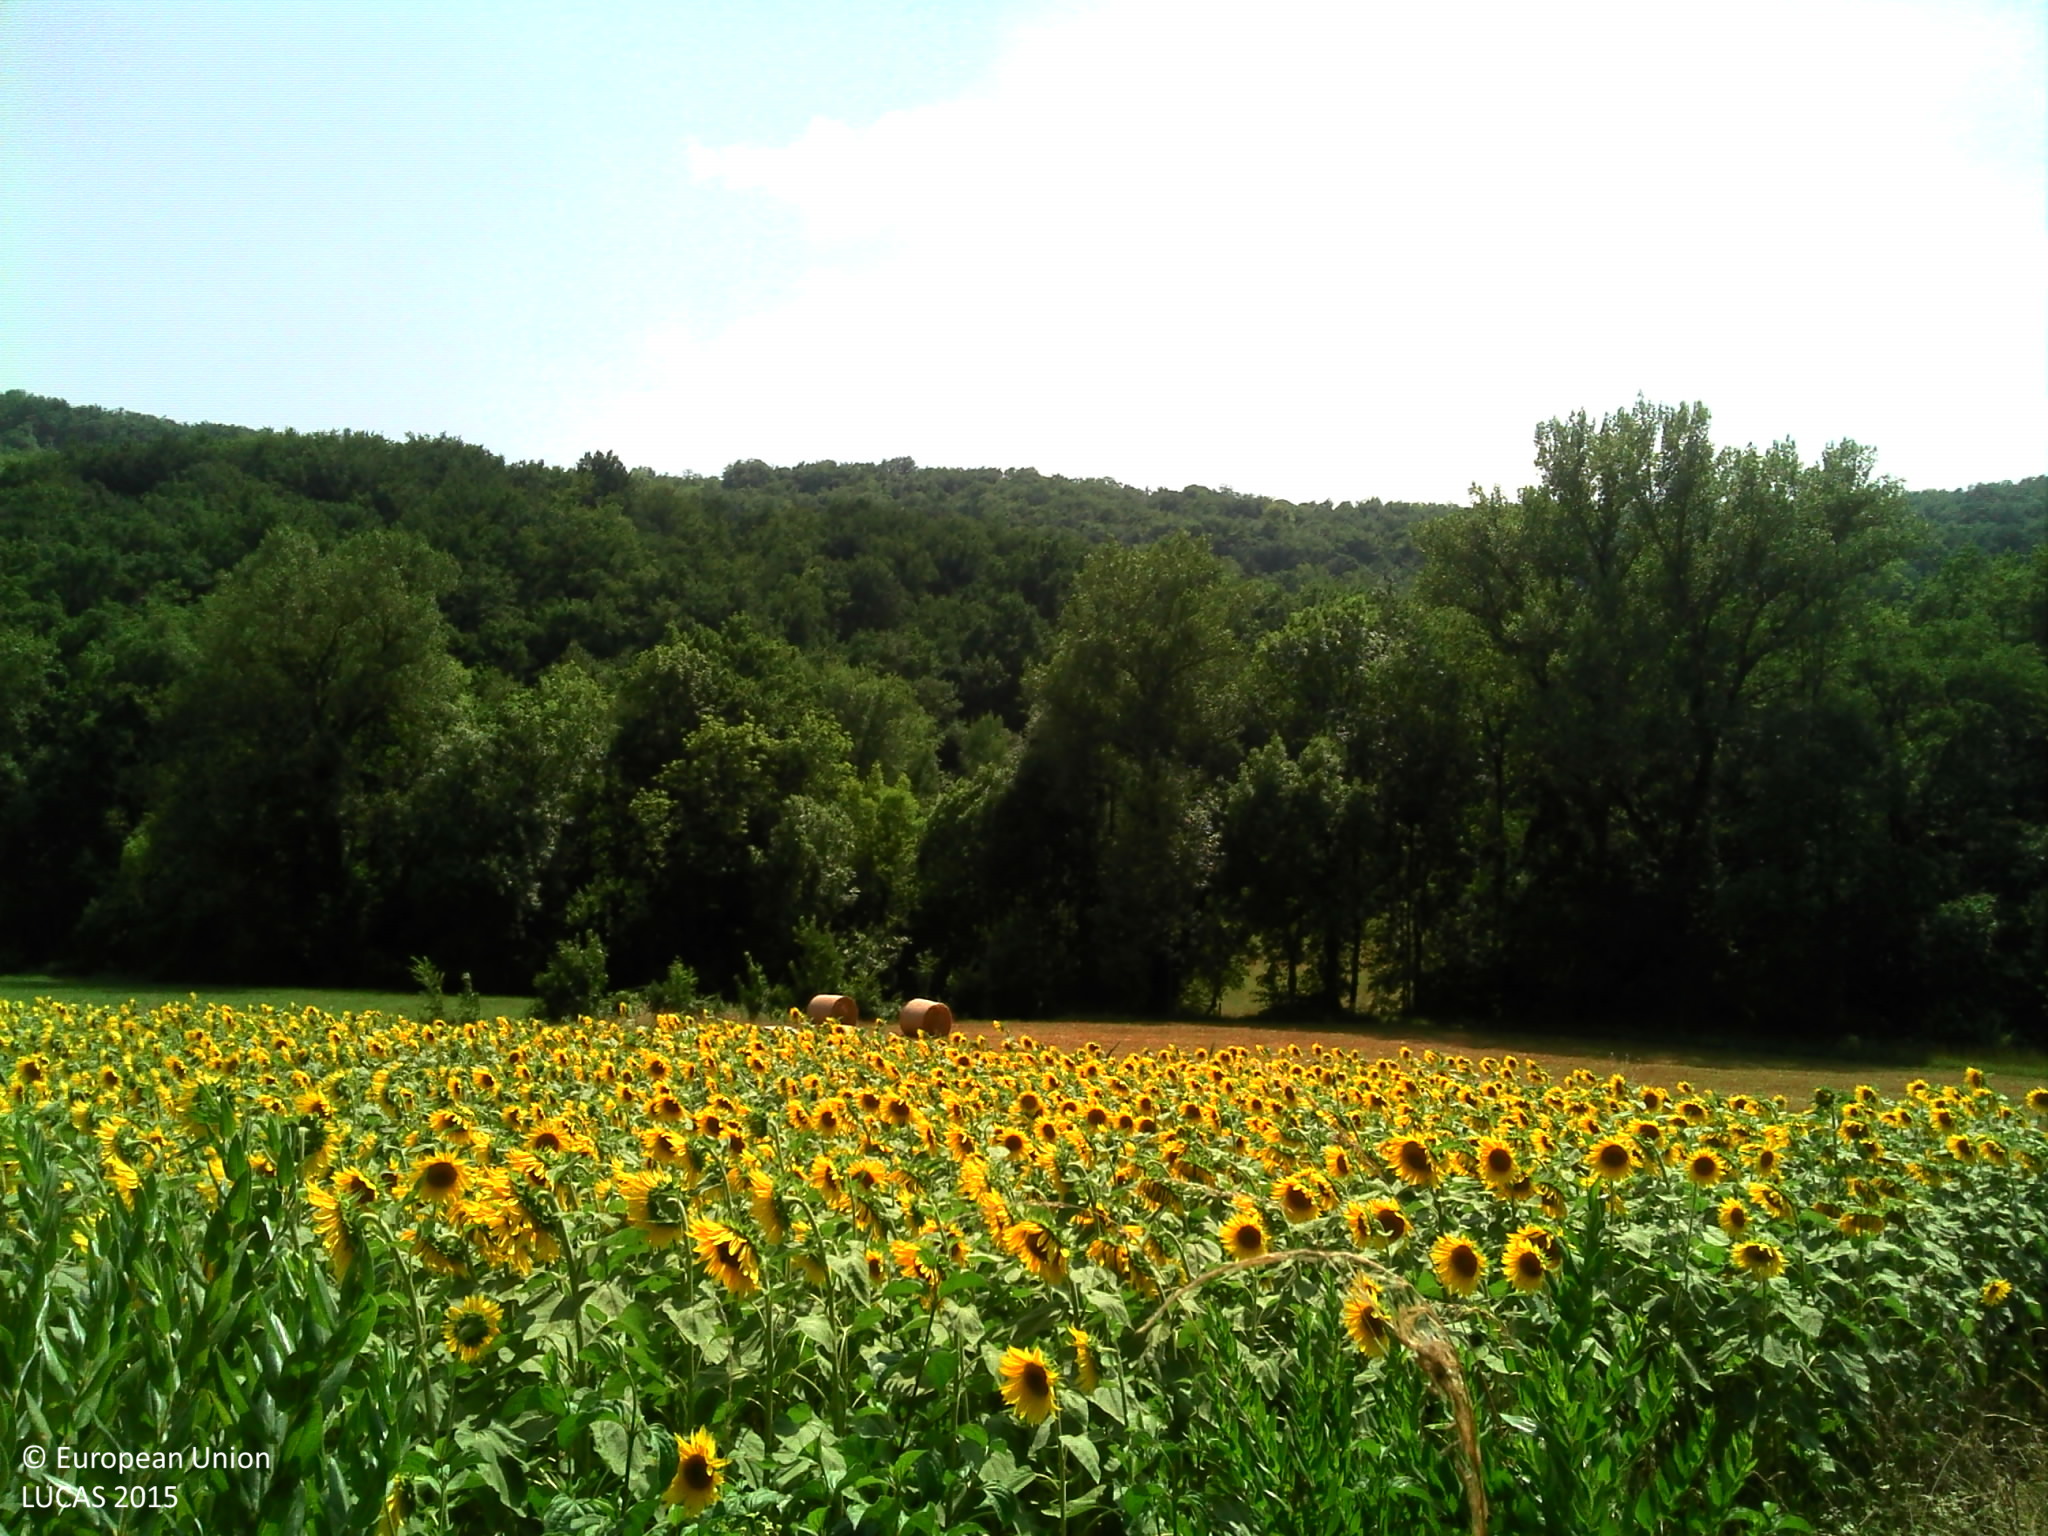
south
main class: Grassland
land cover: Grassland without tree/shrub cover
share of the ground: > 75 %
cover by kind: herbaceous plants 100 %
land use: Agriculture (excluding fallow land and kitchen gardens)
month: July
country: FR
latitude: 43.0878
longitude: 1.4187
